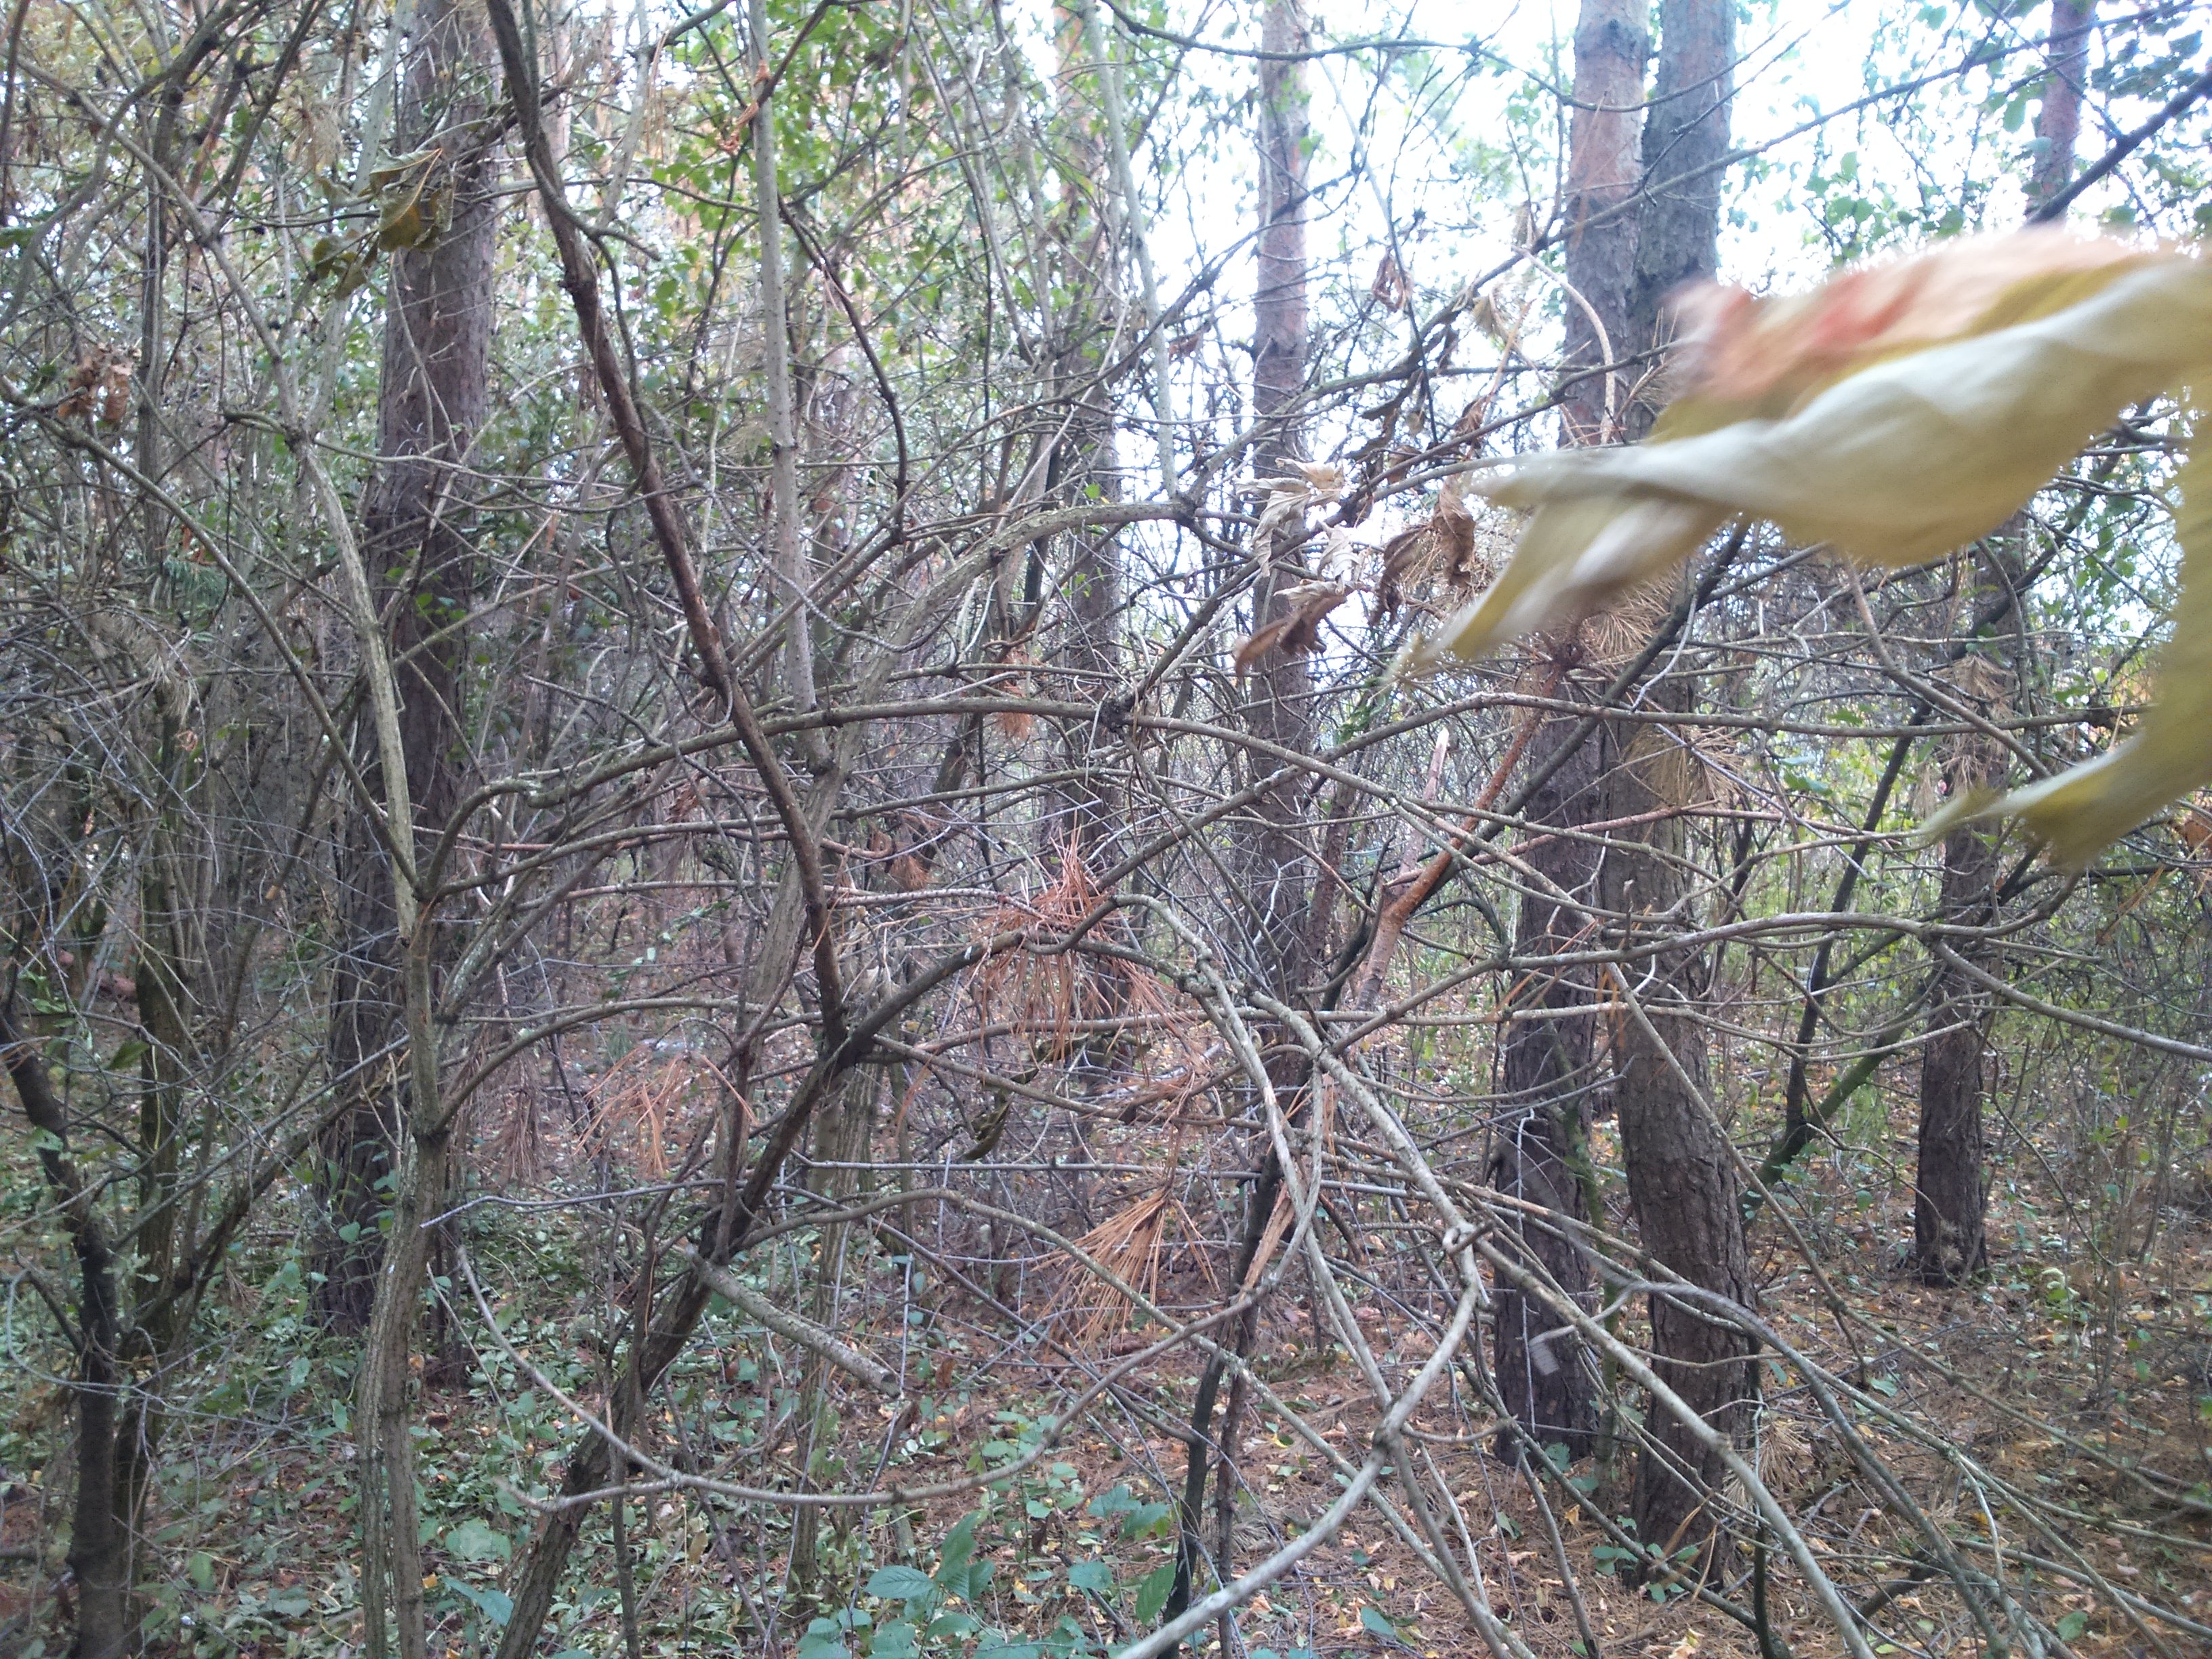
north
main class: Woodland
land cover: Pine dominated coniferous woodland
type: hemiboreal forest and nemoral coniferous forest and mixed broadleaved-coniferous forest
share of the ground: > 75 %
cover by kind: coniferous forest trees 75 %, broadleaved forest trees 15 %, shrubs 10 %
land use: Forestry
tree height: > 5 m
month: October
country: PL
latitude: 52.6991
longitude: 22.3007
